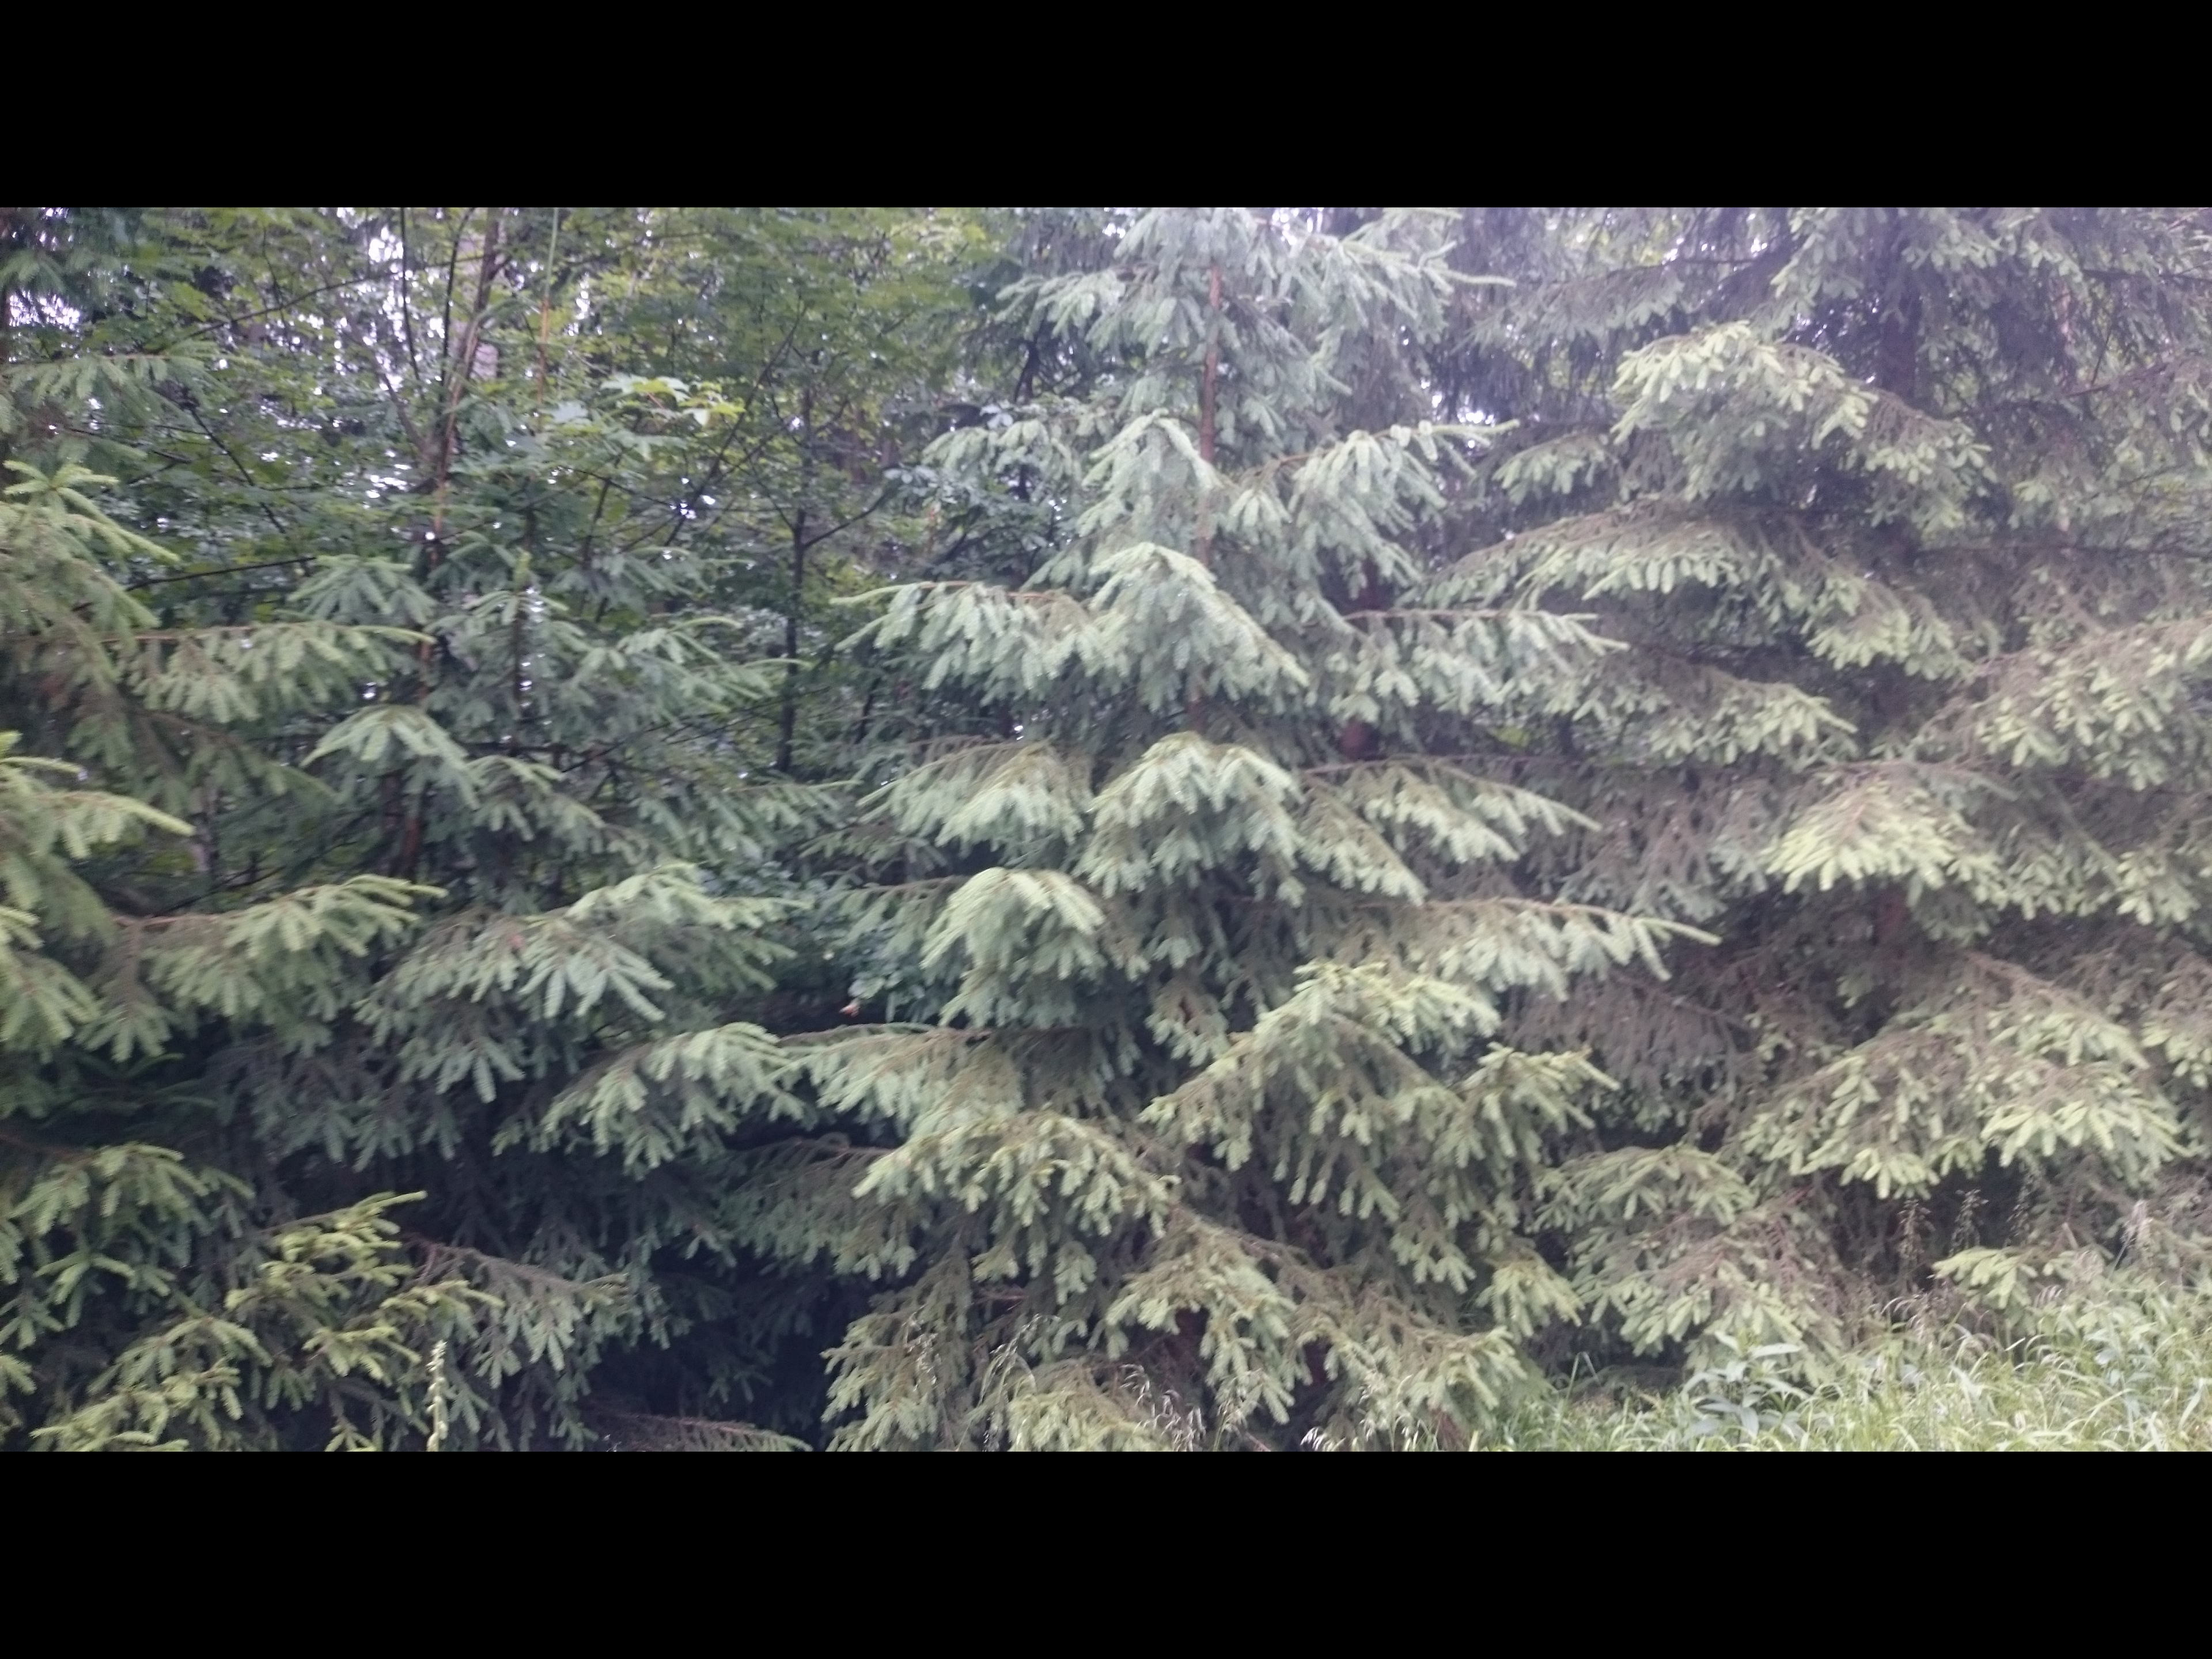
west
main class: Woodland
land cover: Spruce dominated coniferous woodland
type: hemiboreal forest and nemoral coniferous forest and mixed broadleaved-coniferous forest
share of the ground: > 75 %
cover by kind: coniferous forest trees 80 %, shrubs 10 %, unconsolidated bare surface 10 %
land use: Forestry
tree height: > 5 m
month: June
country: AT
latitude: 48.5940
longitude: 14.6517
